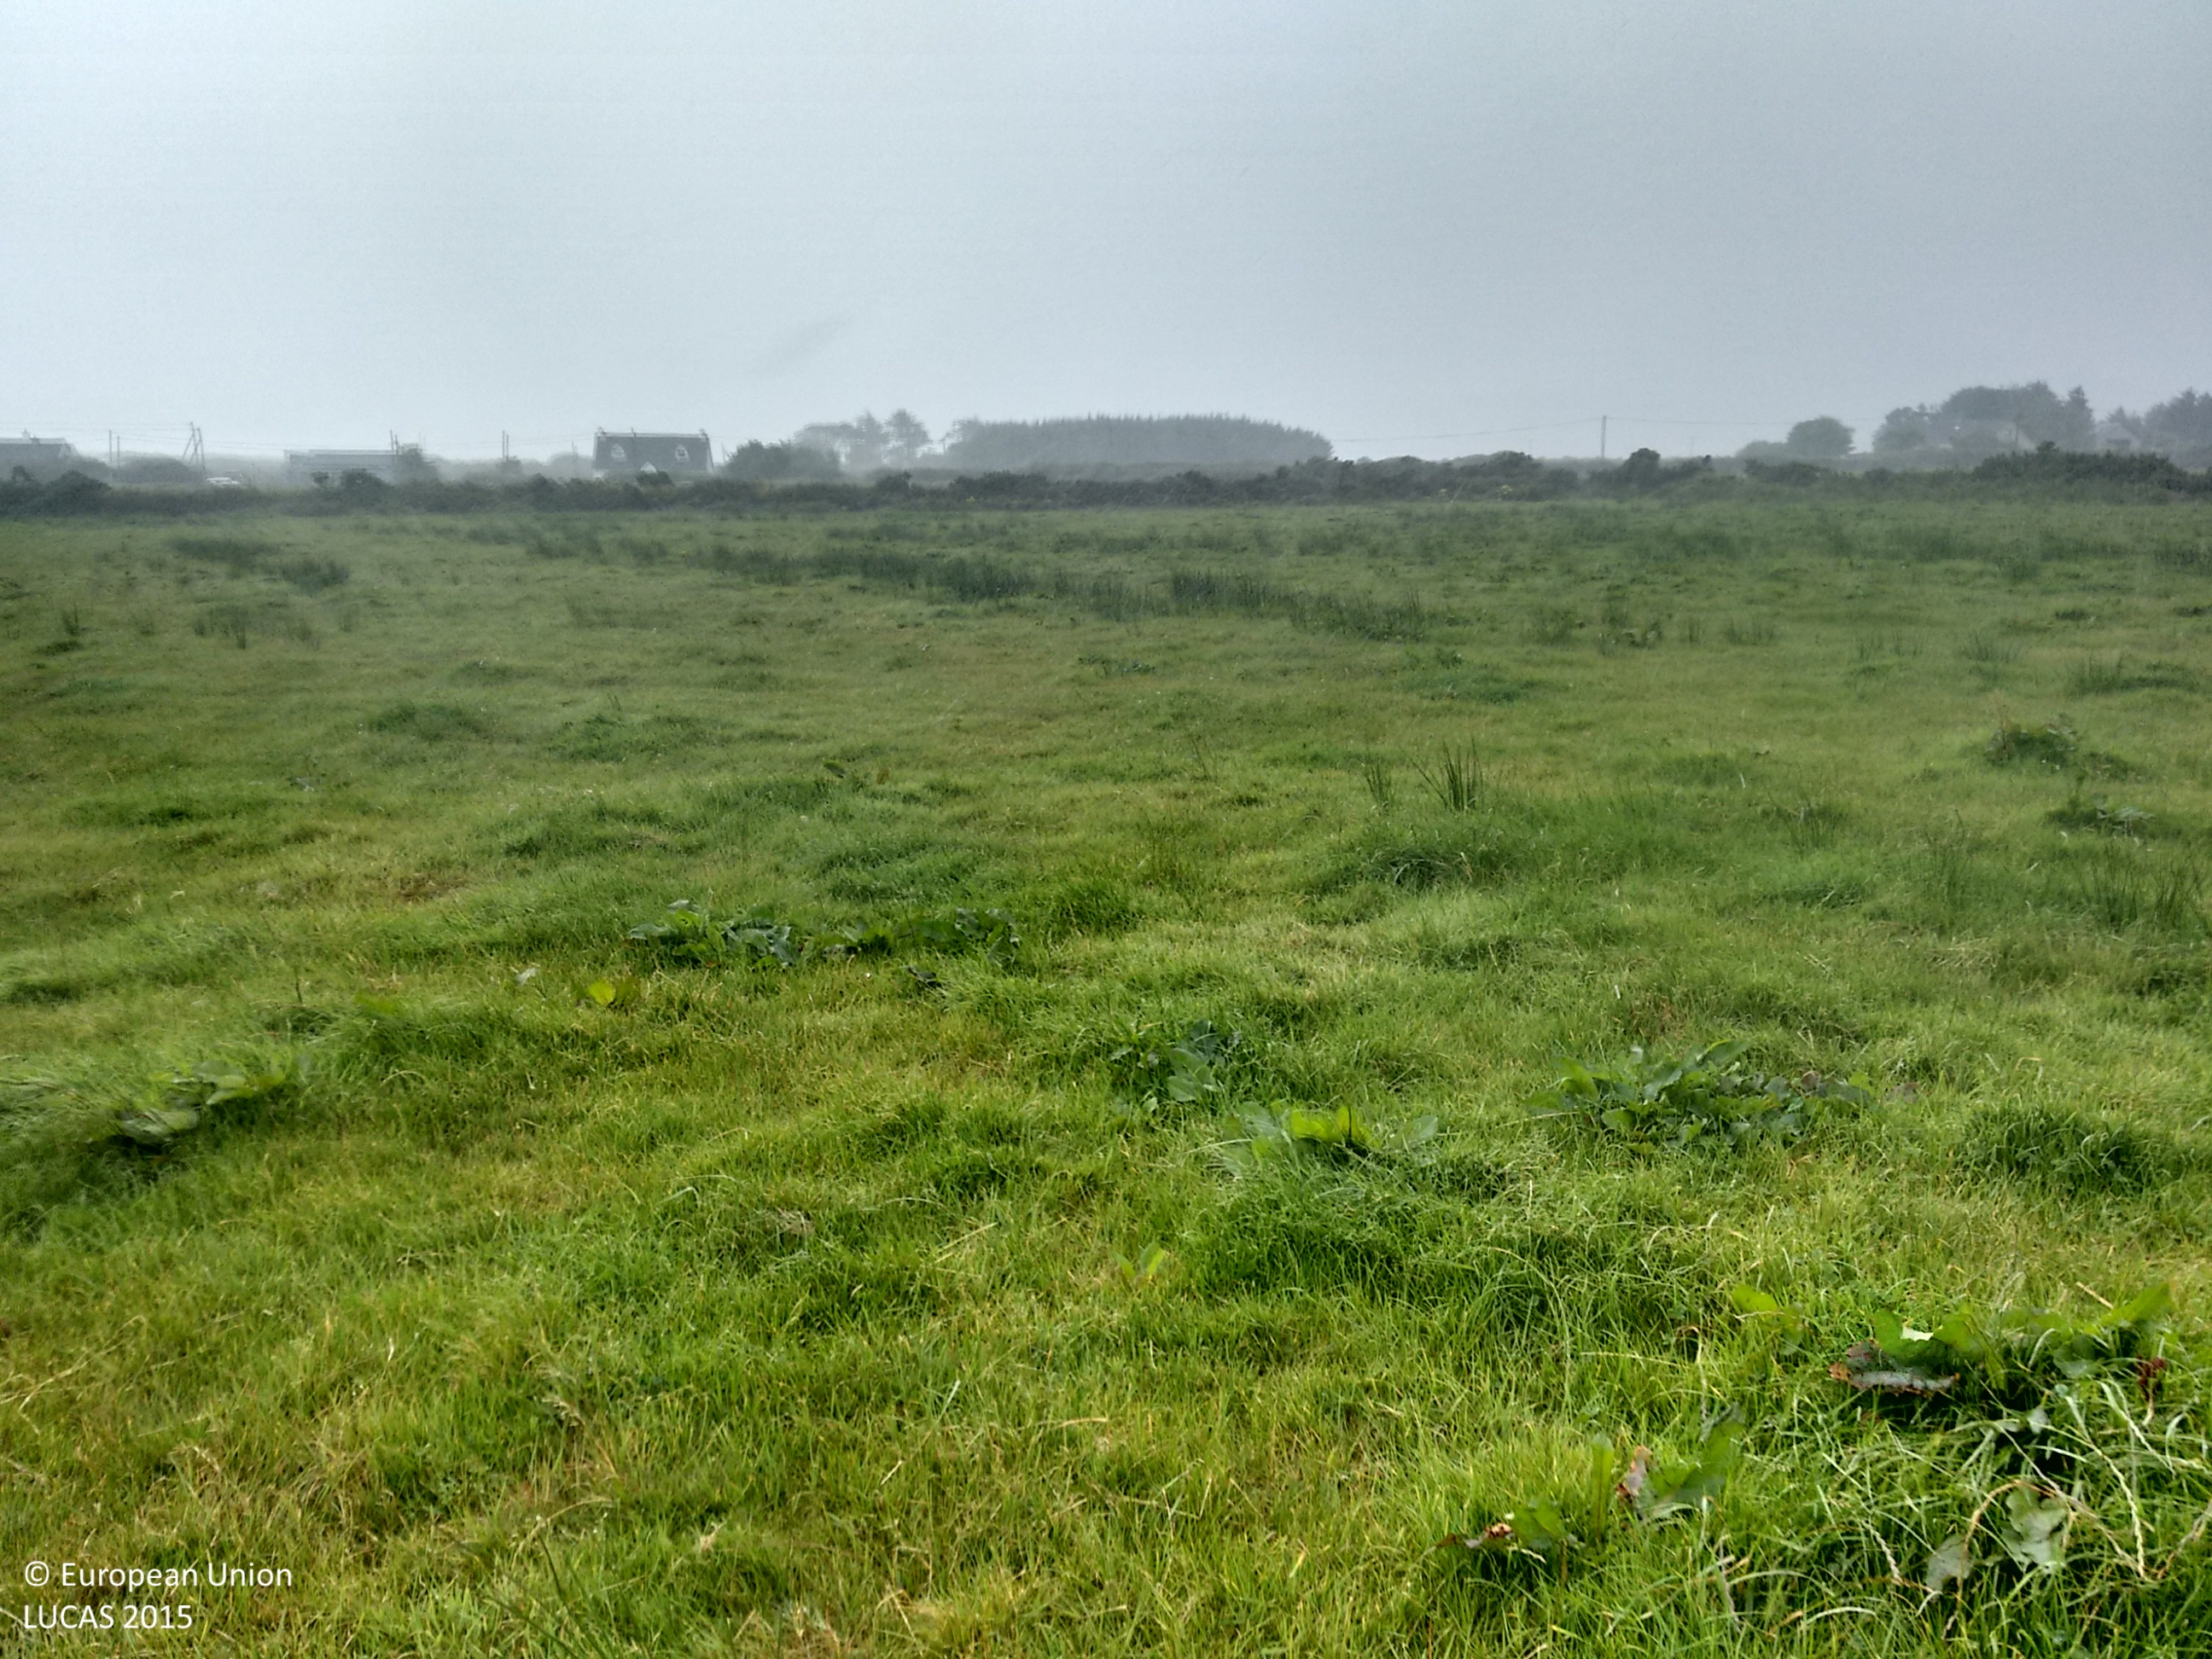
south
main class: Grassland
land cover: Grassland without tree/shrub cover
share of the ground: > 75 %
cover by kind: herbaceous plants 95 %, shrubs 5 %
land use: Agriculture (excluding fallow land and kitchen gardens)
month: August
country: IE
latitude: 51.9065
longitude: -10.3425
